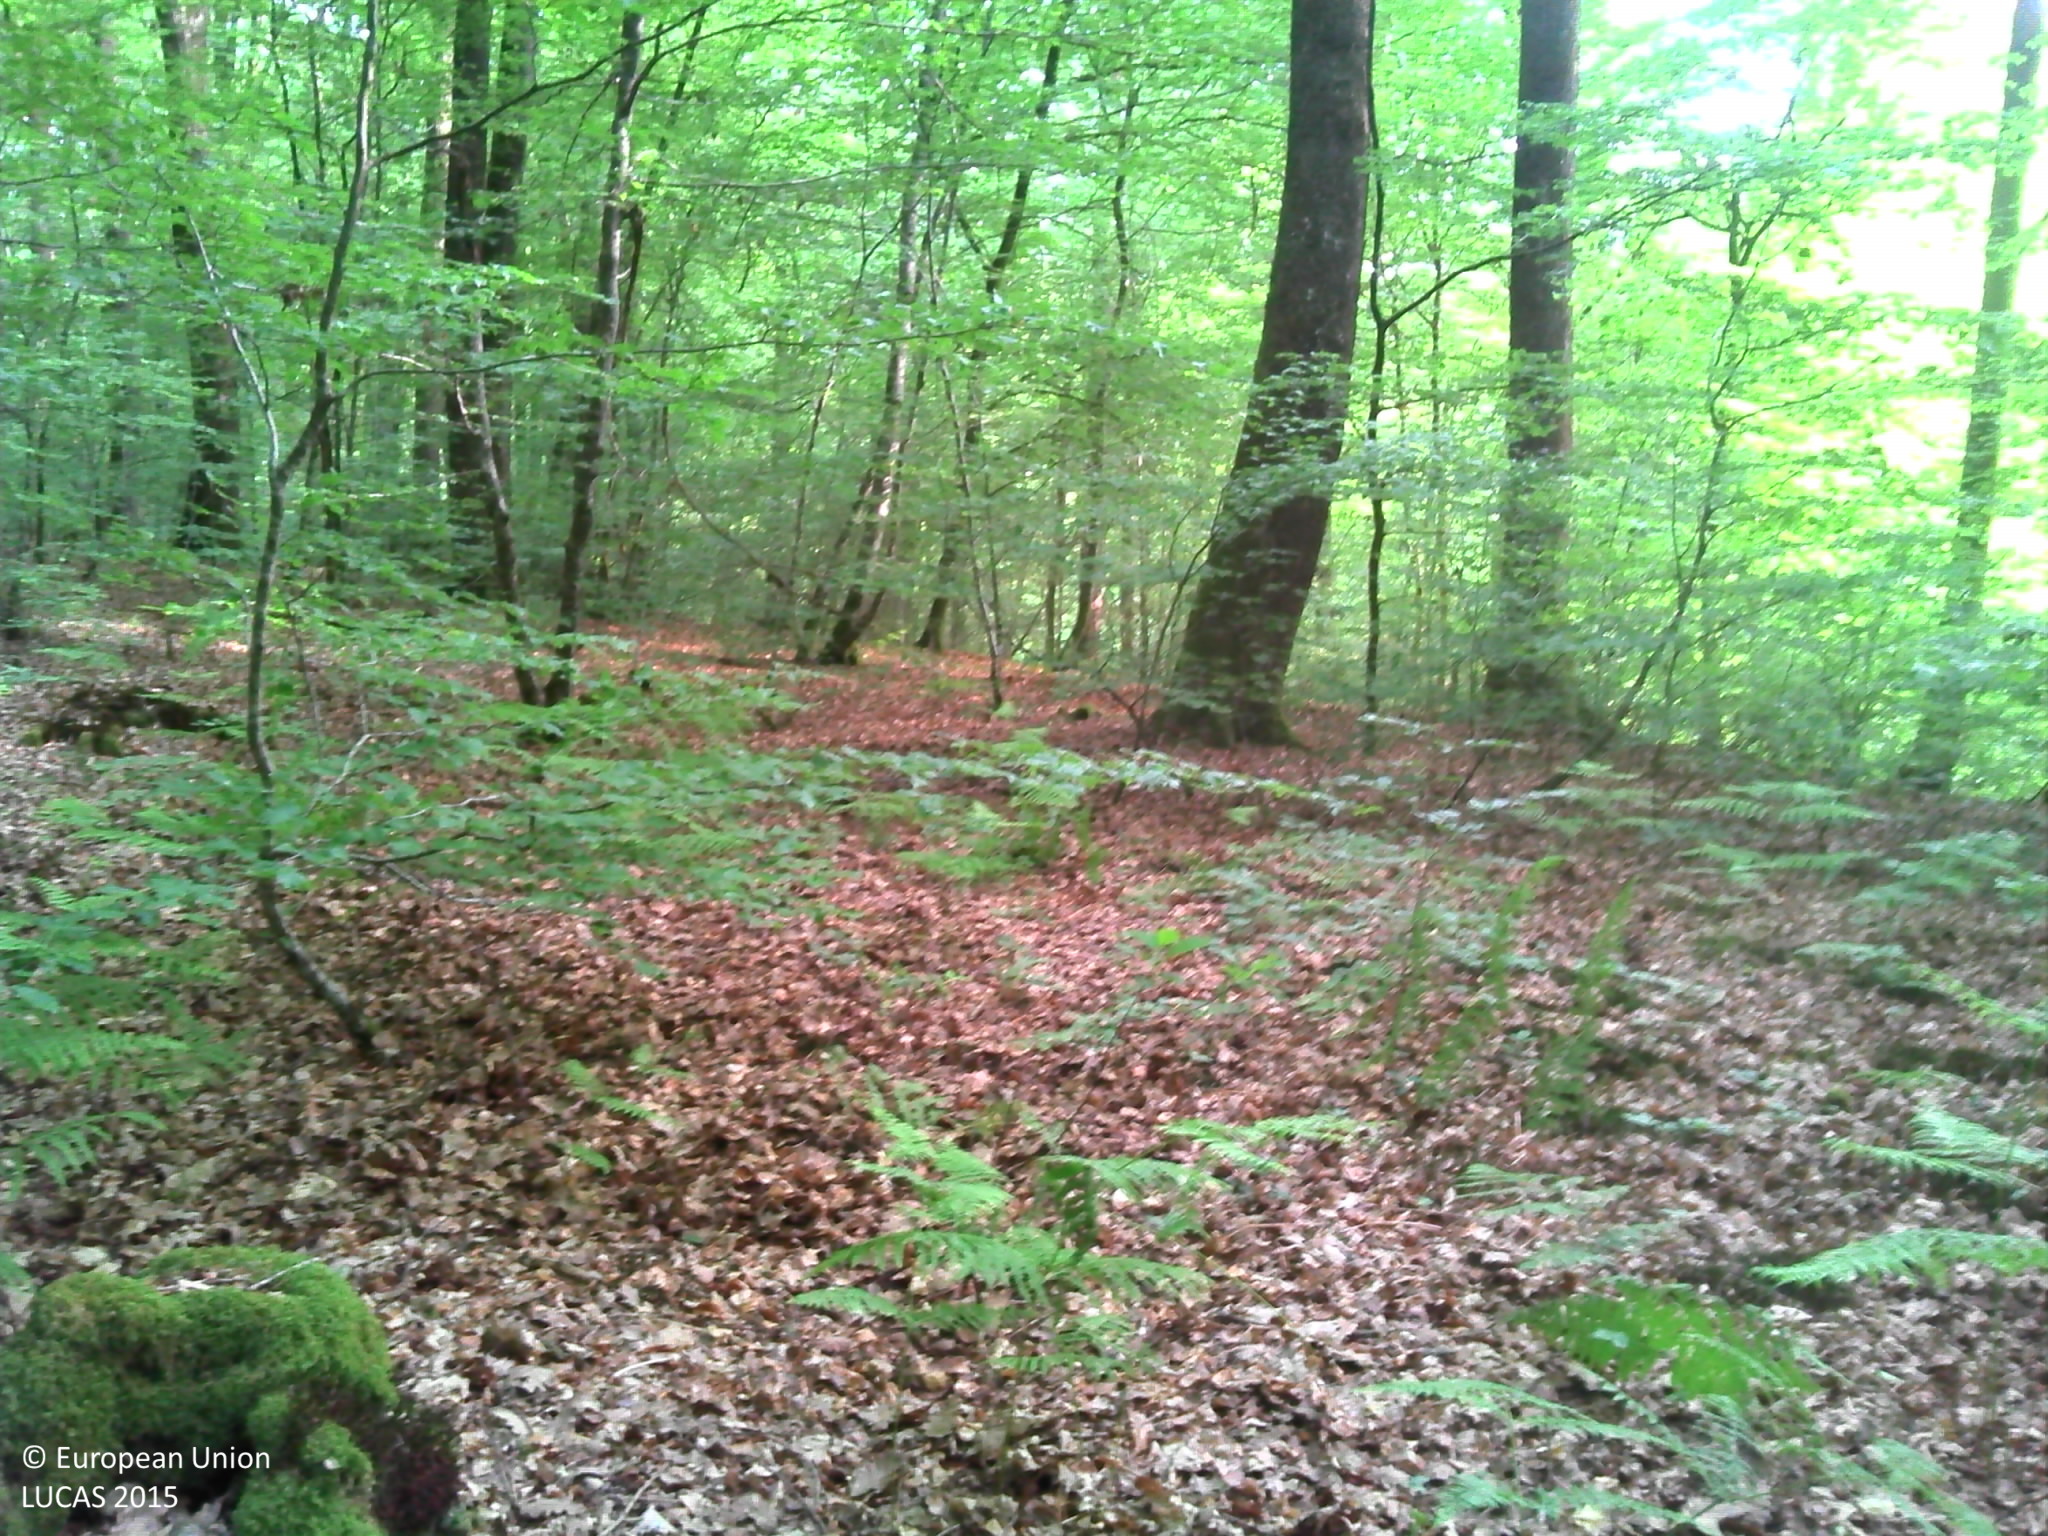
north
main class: Woodland
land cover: Broadleaved woodland
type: beech forest
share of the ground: > 75 %
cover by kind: broadleaved forest trees 95 %, herbaceous plants 5 %
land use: Forestry
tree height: > 5 m
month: June
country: FR
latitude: 47.8308
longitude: 6.1134
